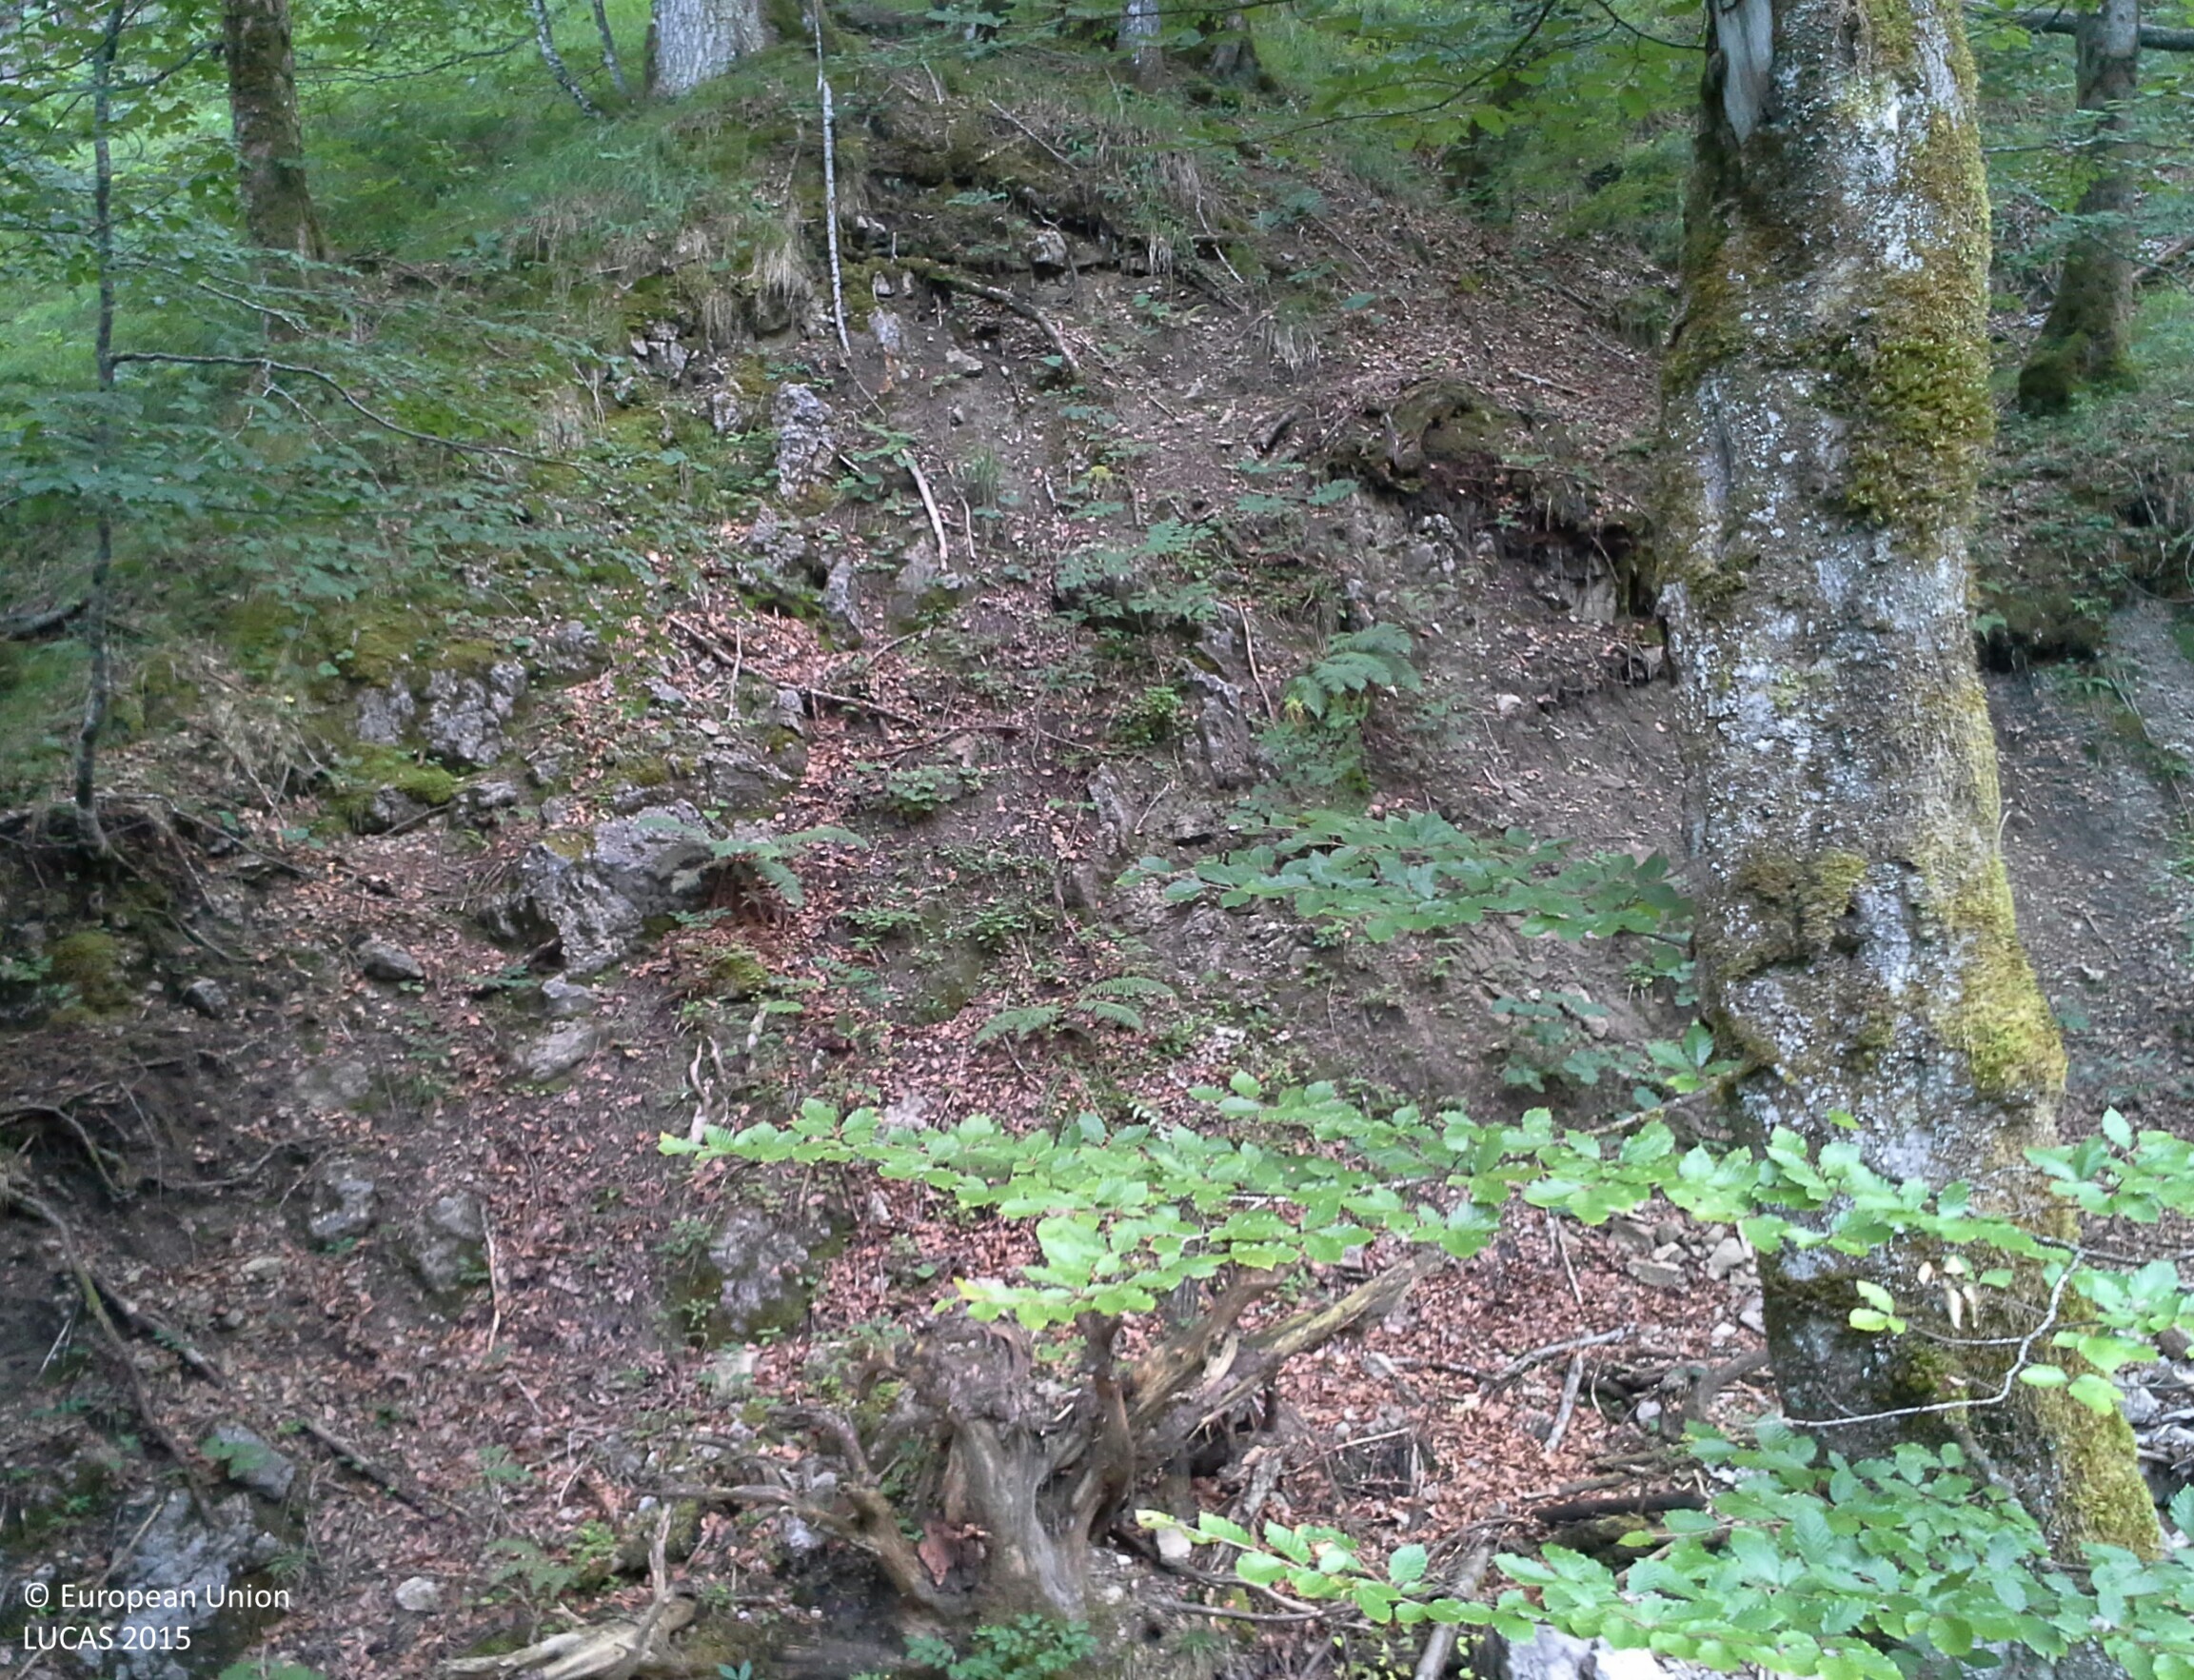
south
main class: Woodland
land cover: Broadleaved woodland
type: mountainous beech forest
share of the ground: > 75 %
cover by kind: broadleaved forest trees 90 %, coniferous forest trees 5 %, shrubs 5 %
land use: Forestry
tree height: > 5 m
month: July
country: AT
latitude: 47.7541
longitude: 14.0143
